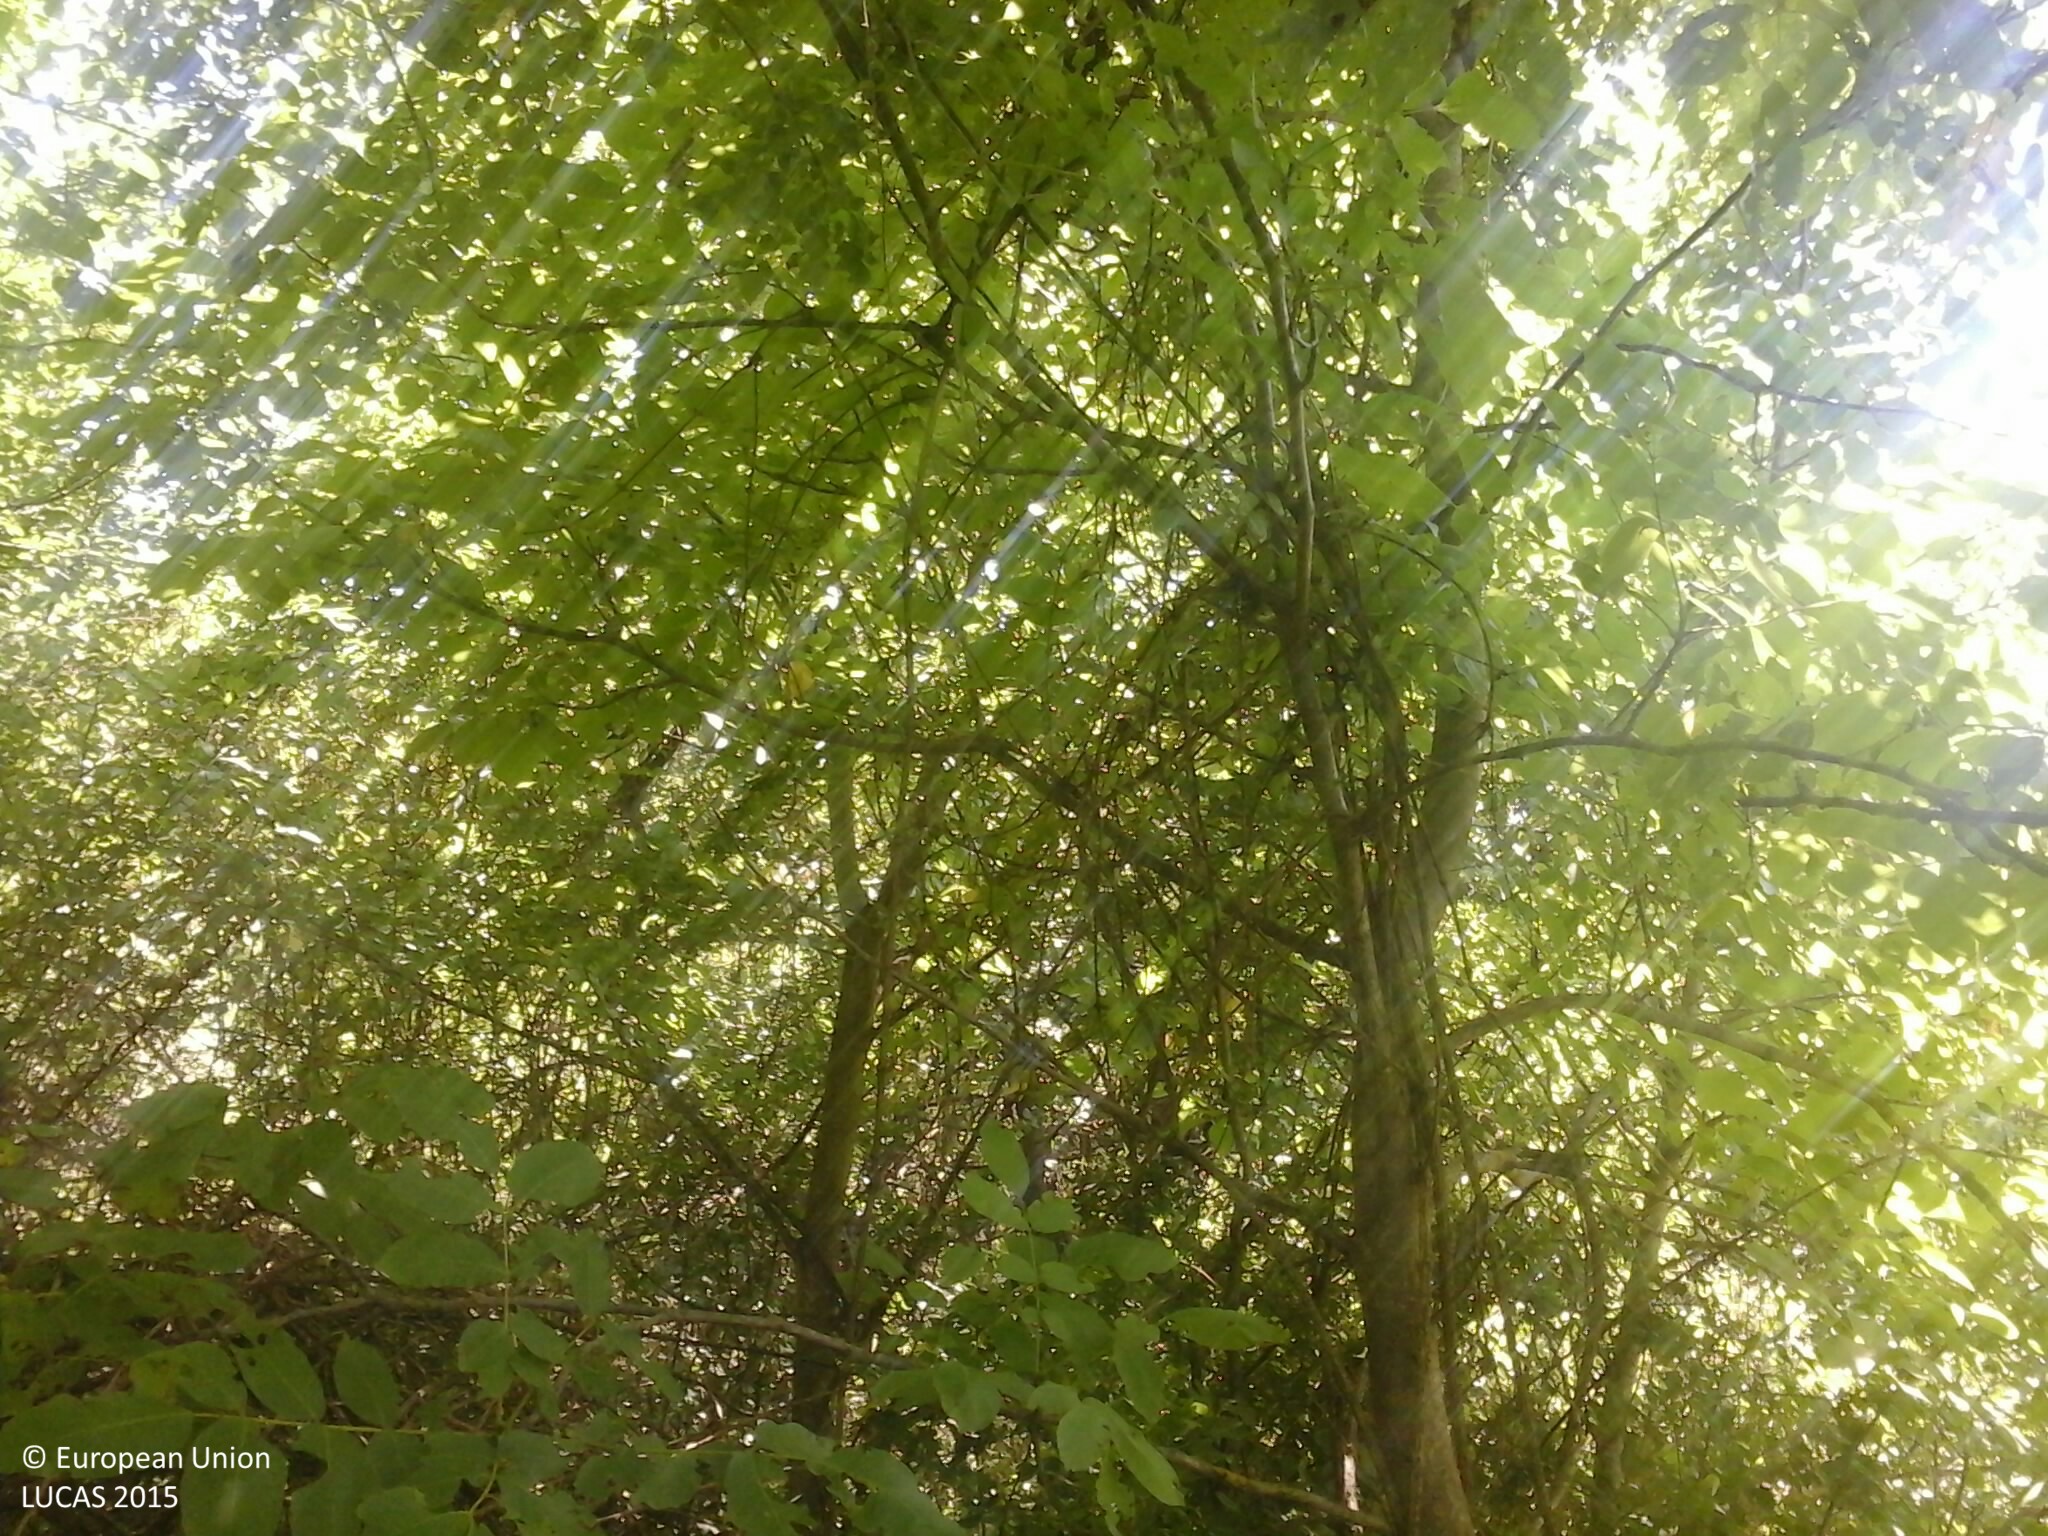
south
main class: Shrubland
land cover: Shrubland with sparse tree cover
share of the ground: > 75 %
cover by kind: shrubs 75 %, herbaceous plants 20 %, broadleaved forest trees 5 %
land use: Semi-natural and natural areas not in use
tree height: < 5 m
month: August
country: HU
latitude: 46.7781
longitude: 17.9581
